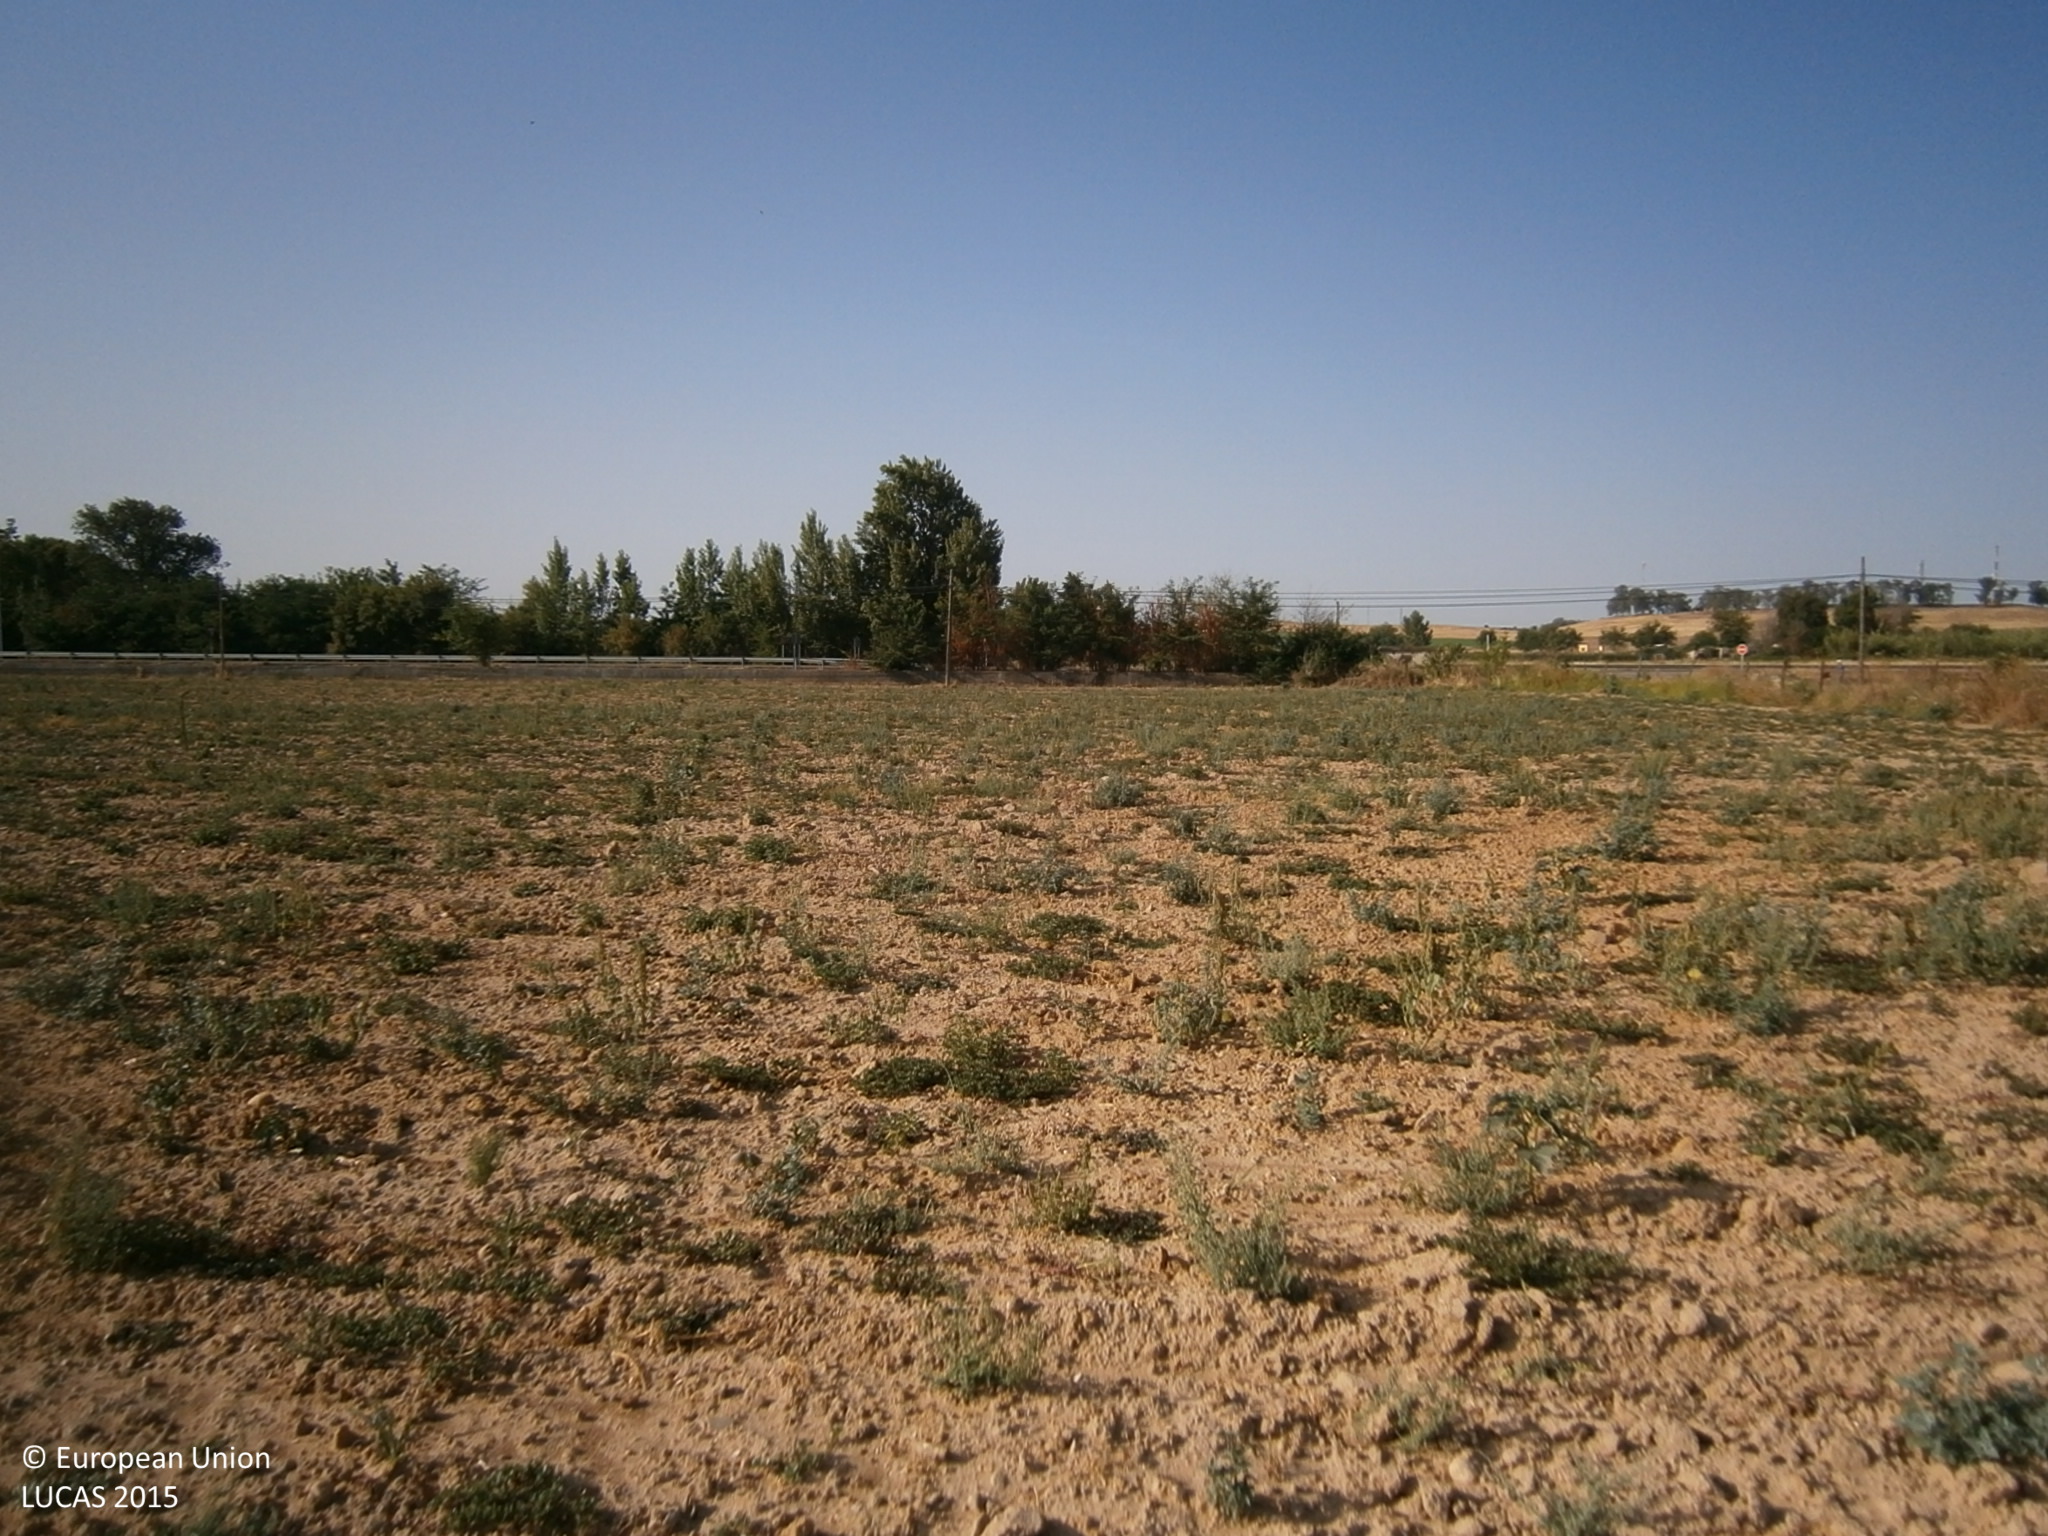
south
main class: Grassland
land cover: Spontaneously vegetated surfaces
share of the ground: > 75 %
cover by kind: unconsolidated bare surface 90 %, herbaceous plants 10 %
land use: Fallow land
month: July
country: ES
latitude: 38.8877
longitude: -6.8647
